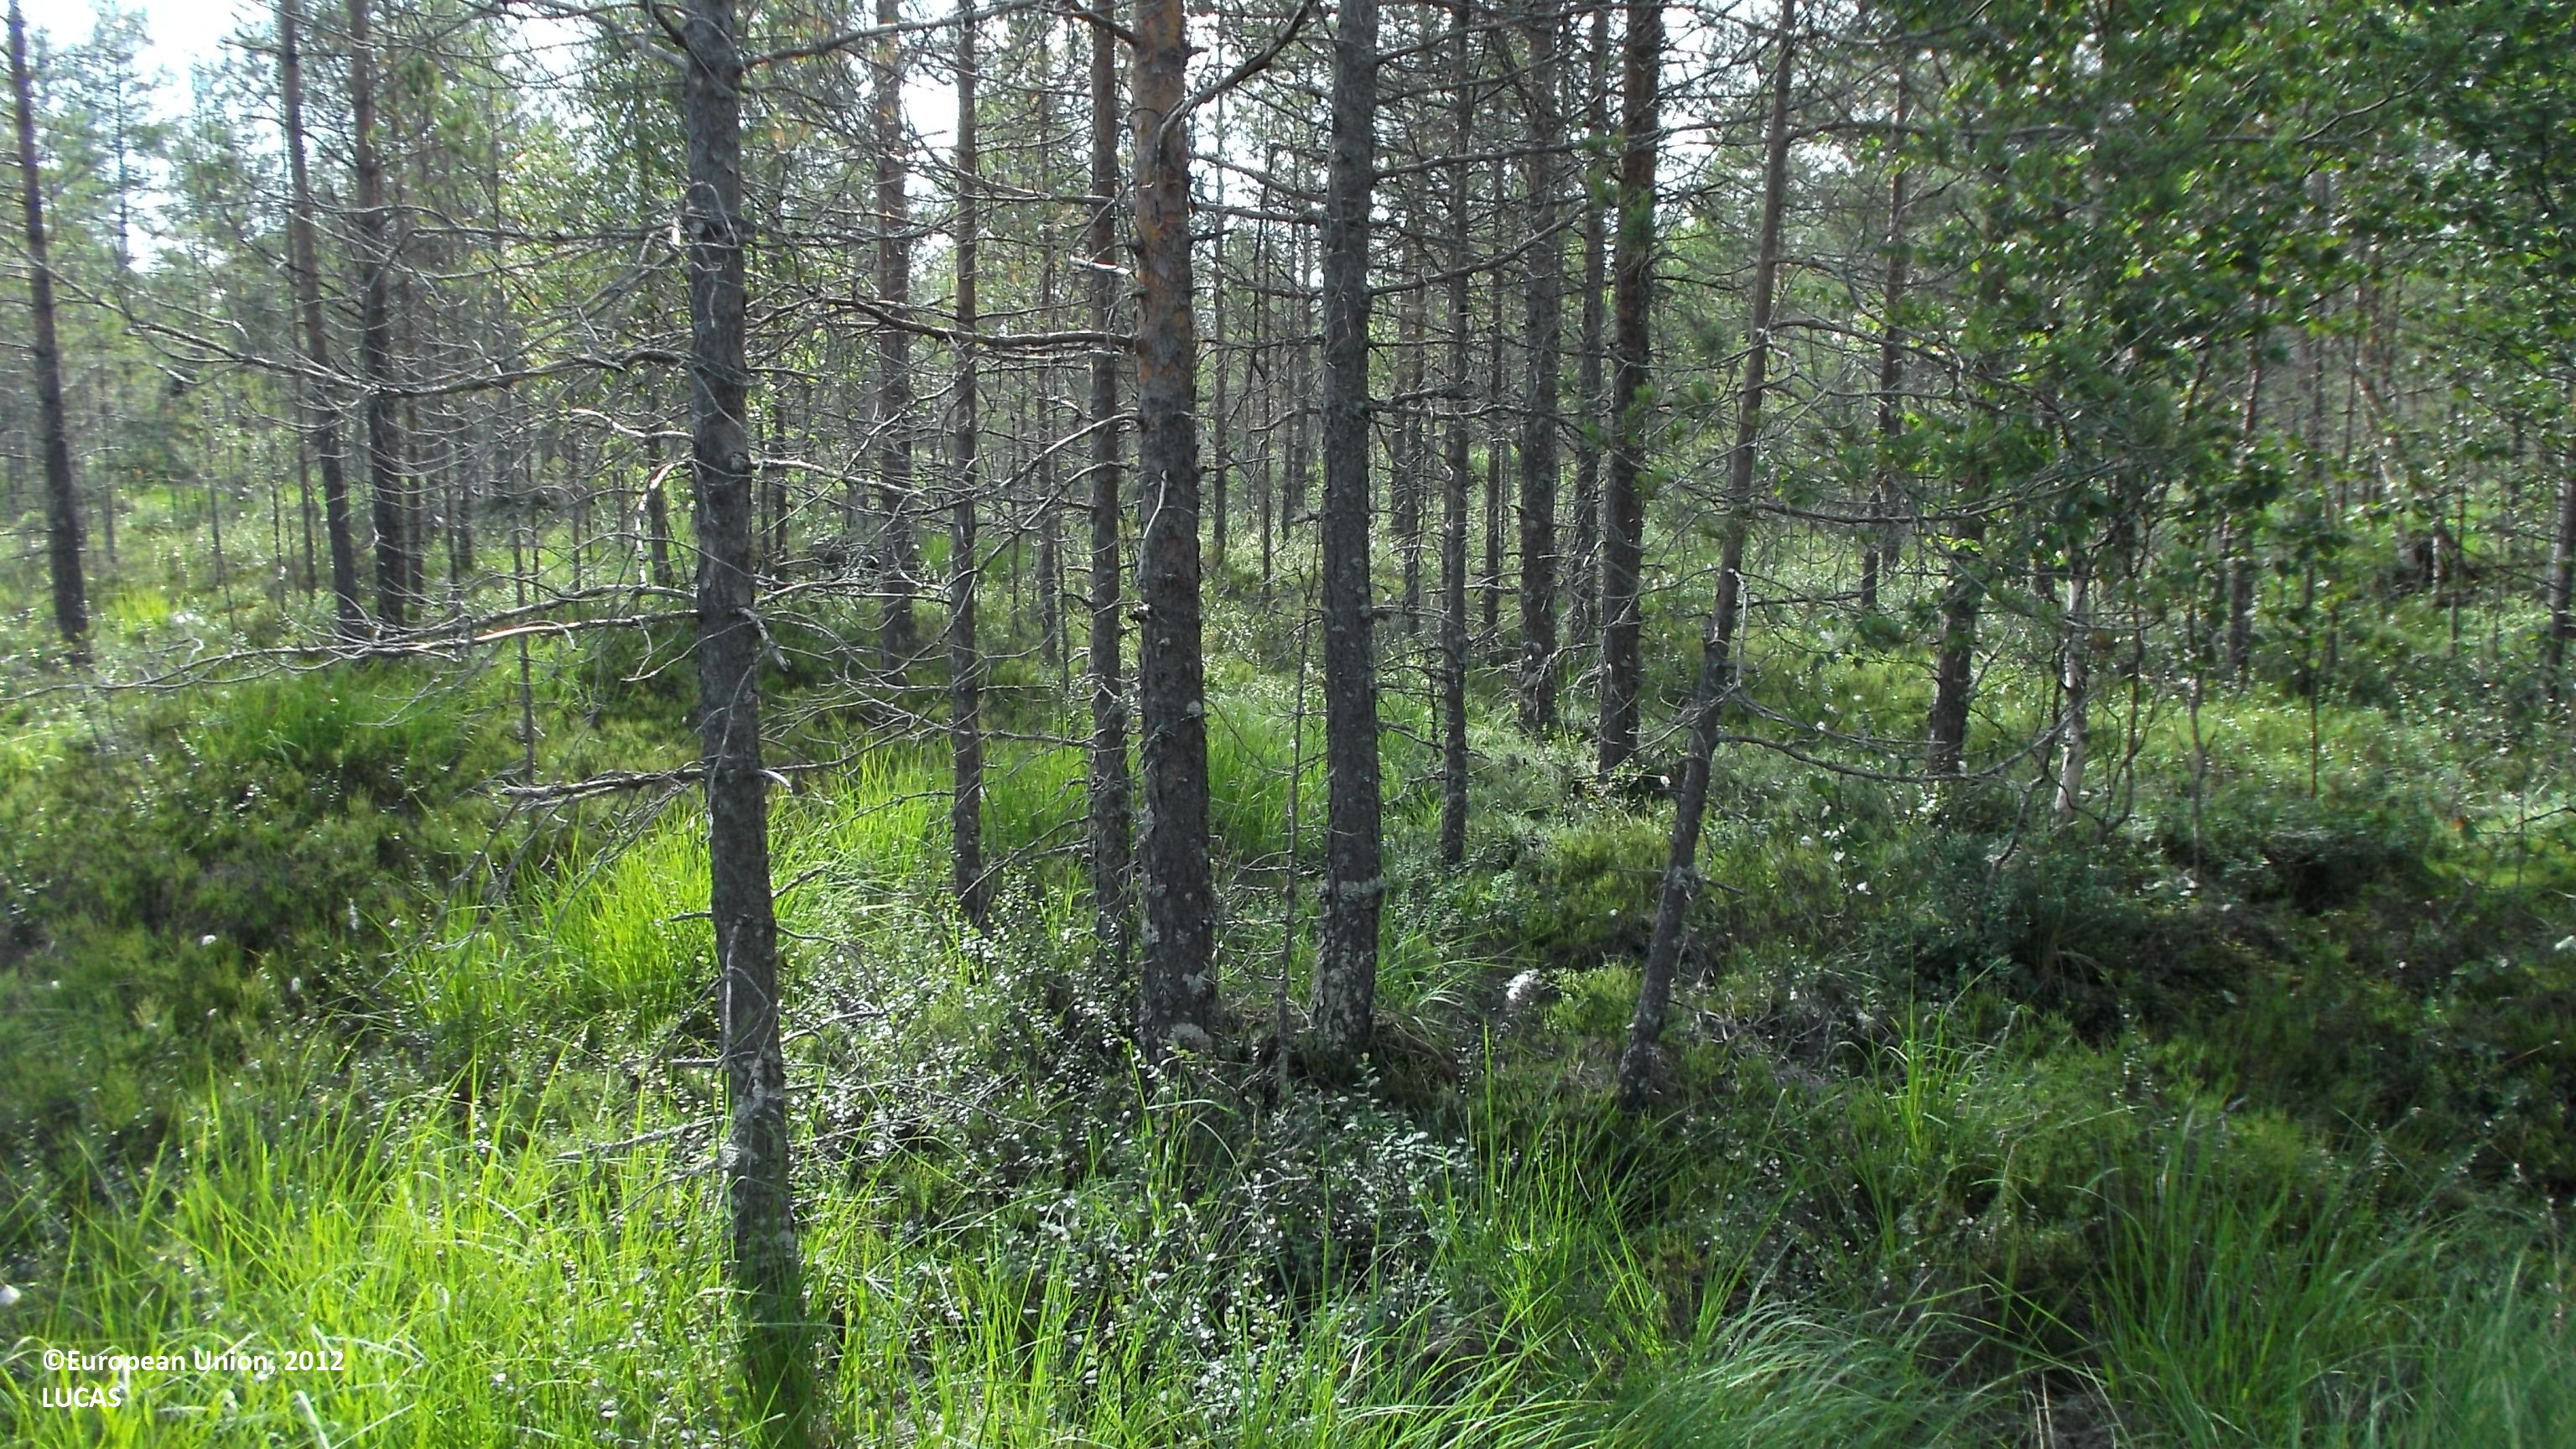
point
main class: Woodland
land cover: Pine dominated mixed woodland
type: mire and swamp forests
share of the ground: 25 - 50 %
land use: Forestry
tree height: > 5 m
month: July
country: FI
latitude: 63.4160
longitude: 24.4813
